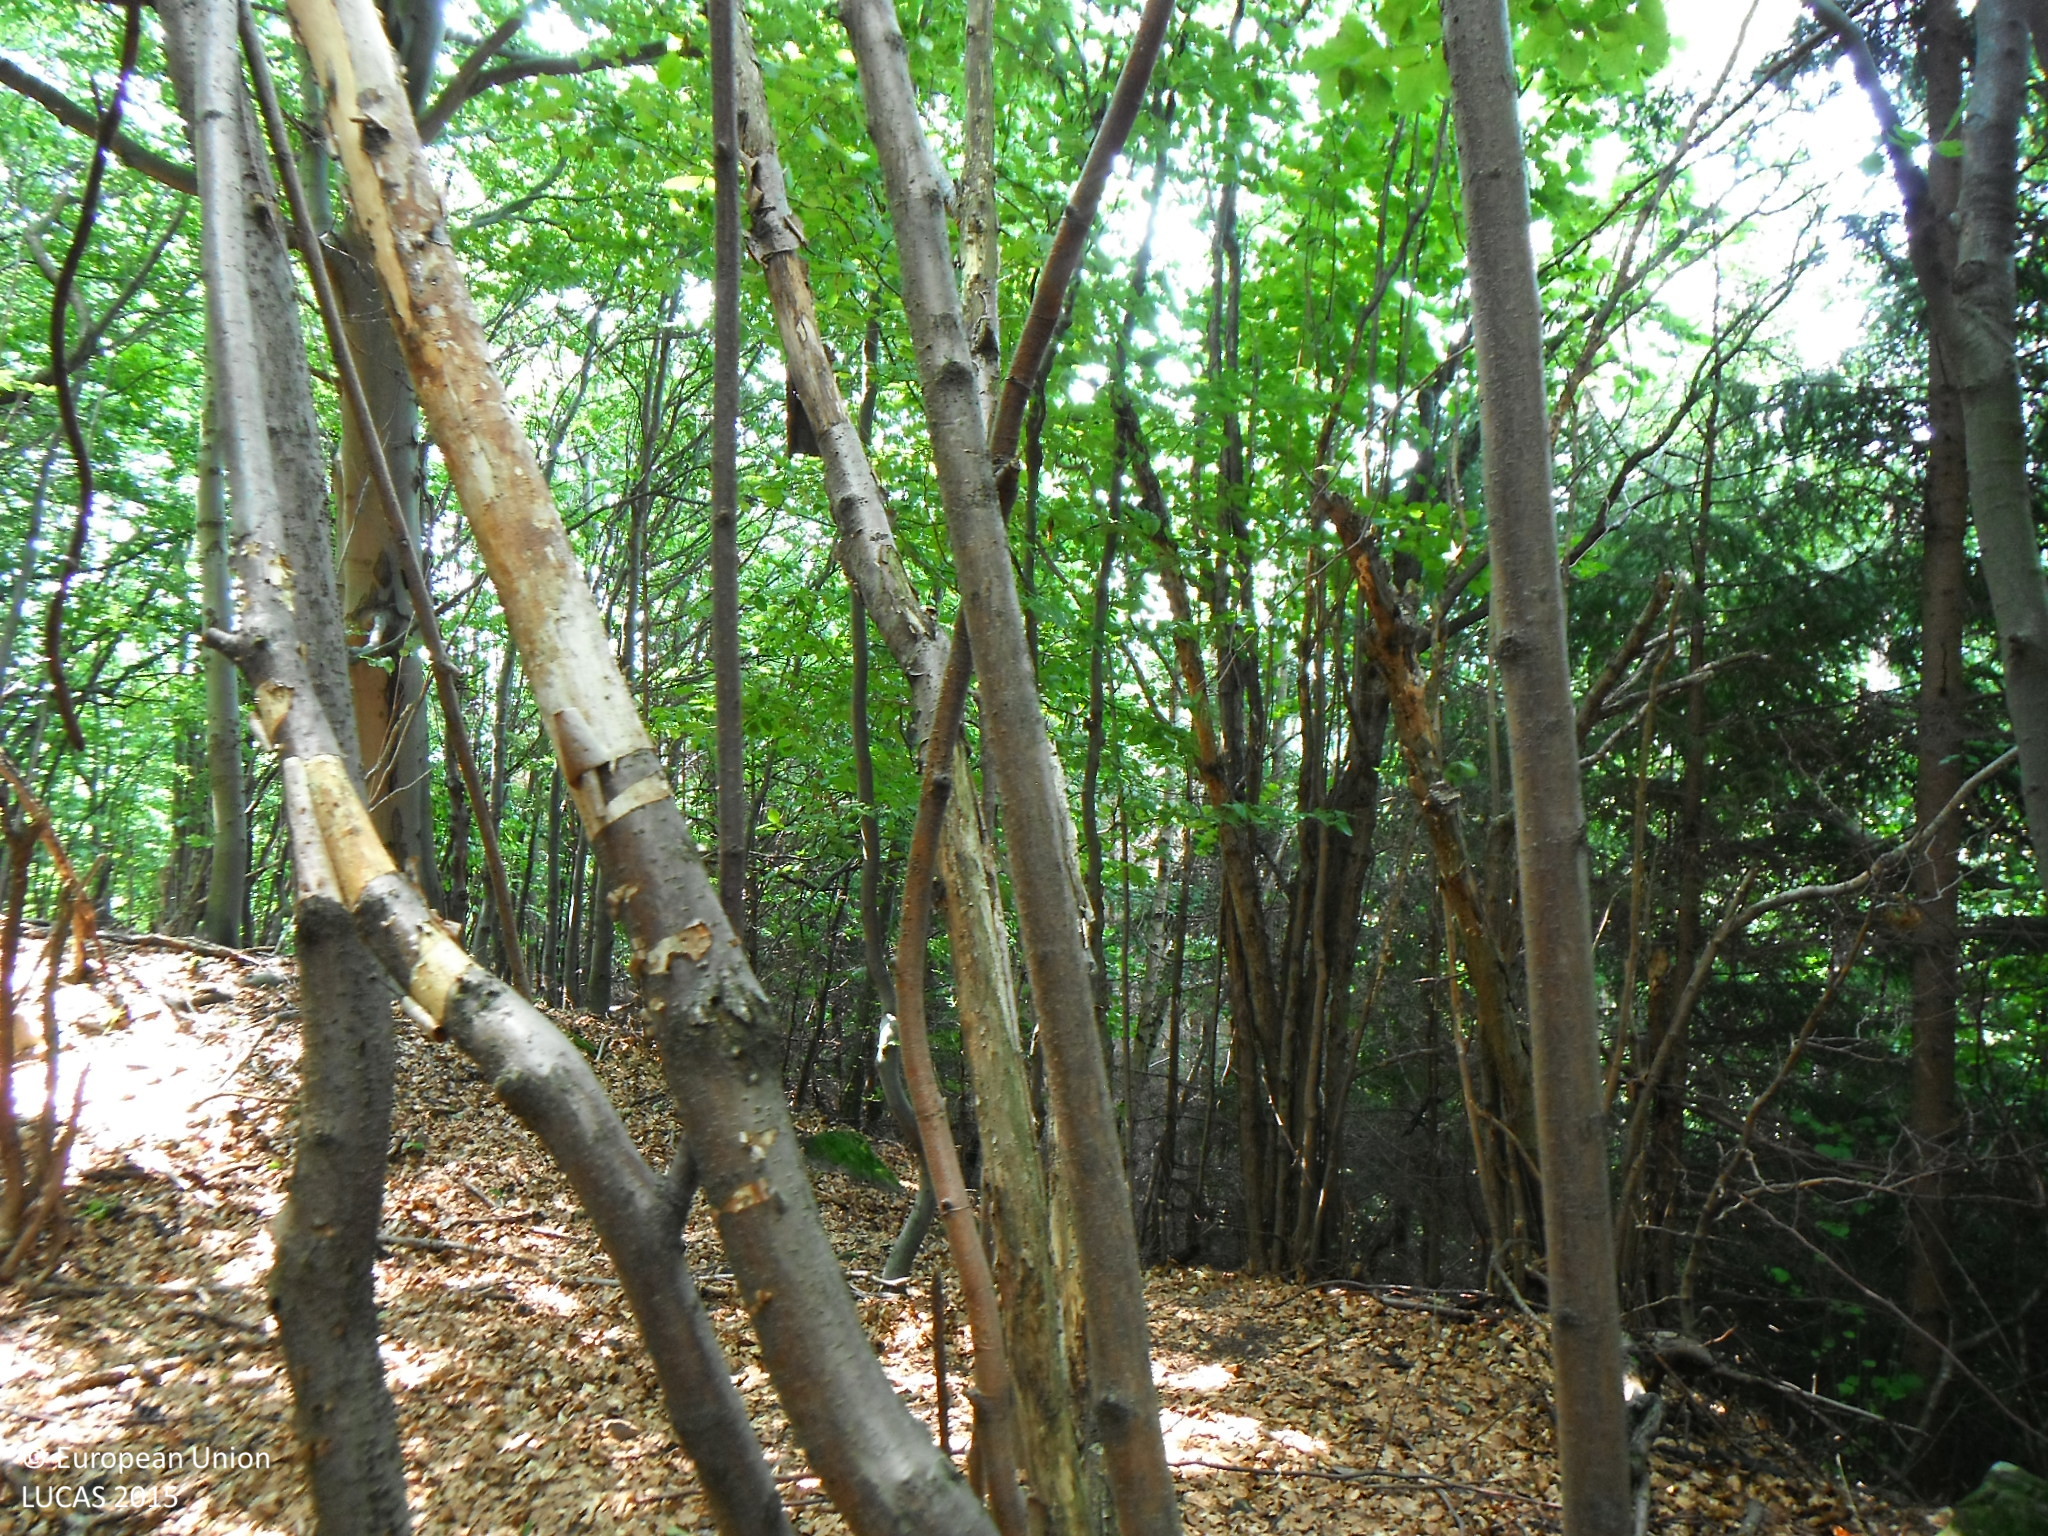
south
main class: Woodland
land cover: Broadleaved woodland
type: beech forest
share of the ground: > 75 %
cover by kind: broadleaved forest trees 85 %, coniferous forest trees 15 %
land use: Forestry
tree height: > 5 m
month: July
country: SK
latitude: 49.4225
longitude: 21.2821
